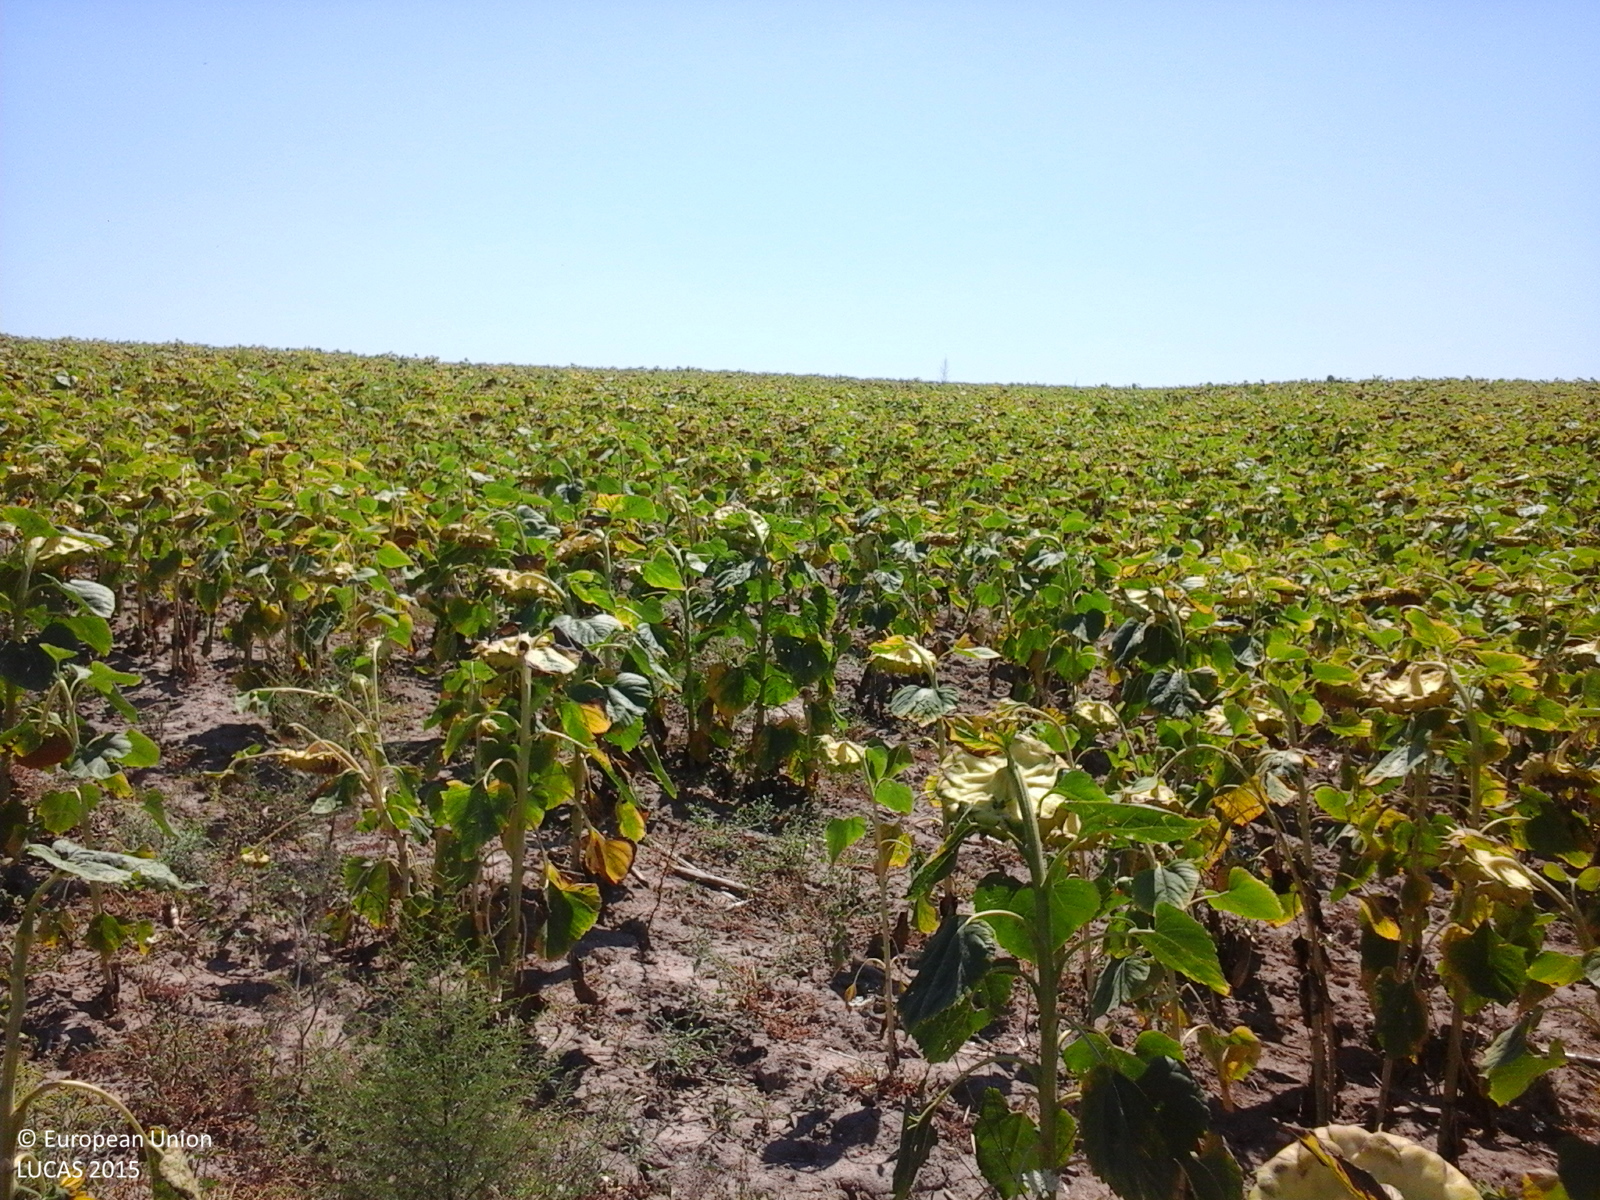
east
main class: Cropland
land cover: Sunflower
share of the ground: > 75 %
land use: Agriculture (excluding fallow land and kitchen gardens)
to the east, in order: Sunflower
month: August
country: RO
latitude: 44.6856
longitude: 28.1699
